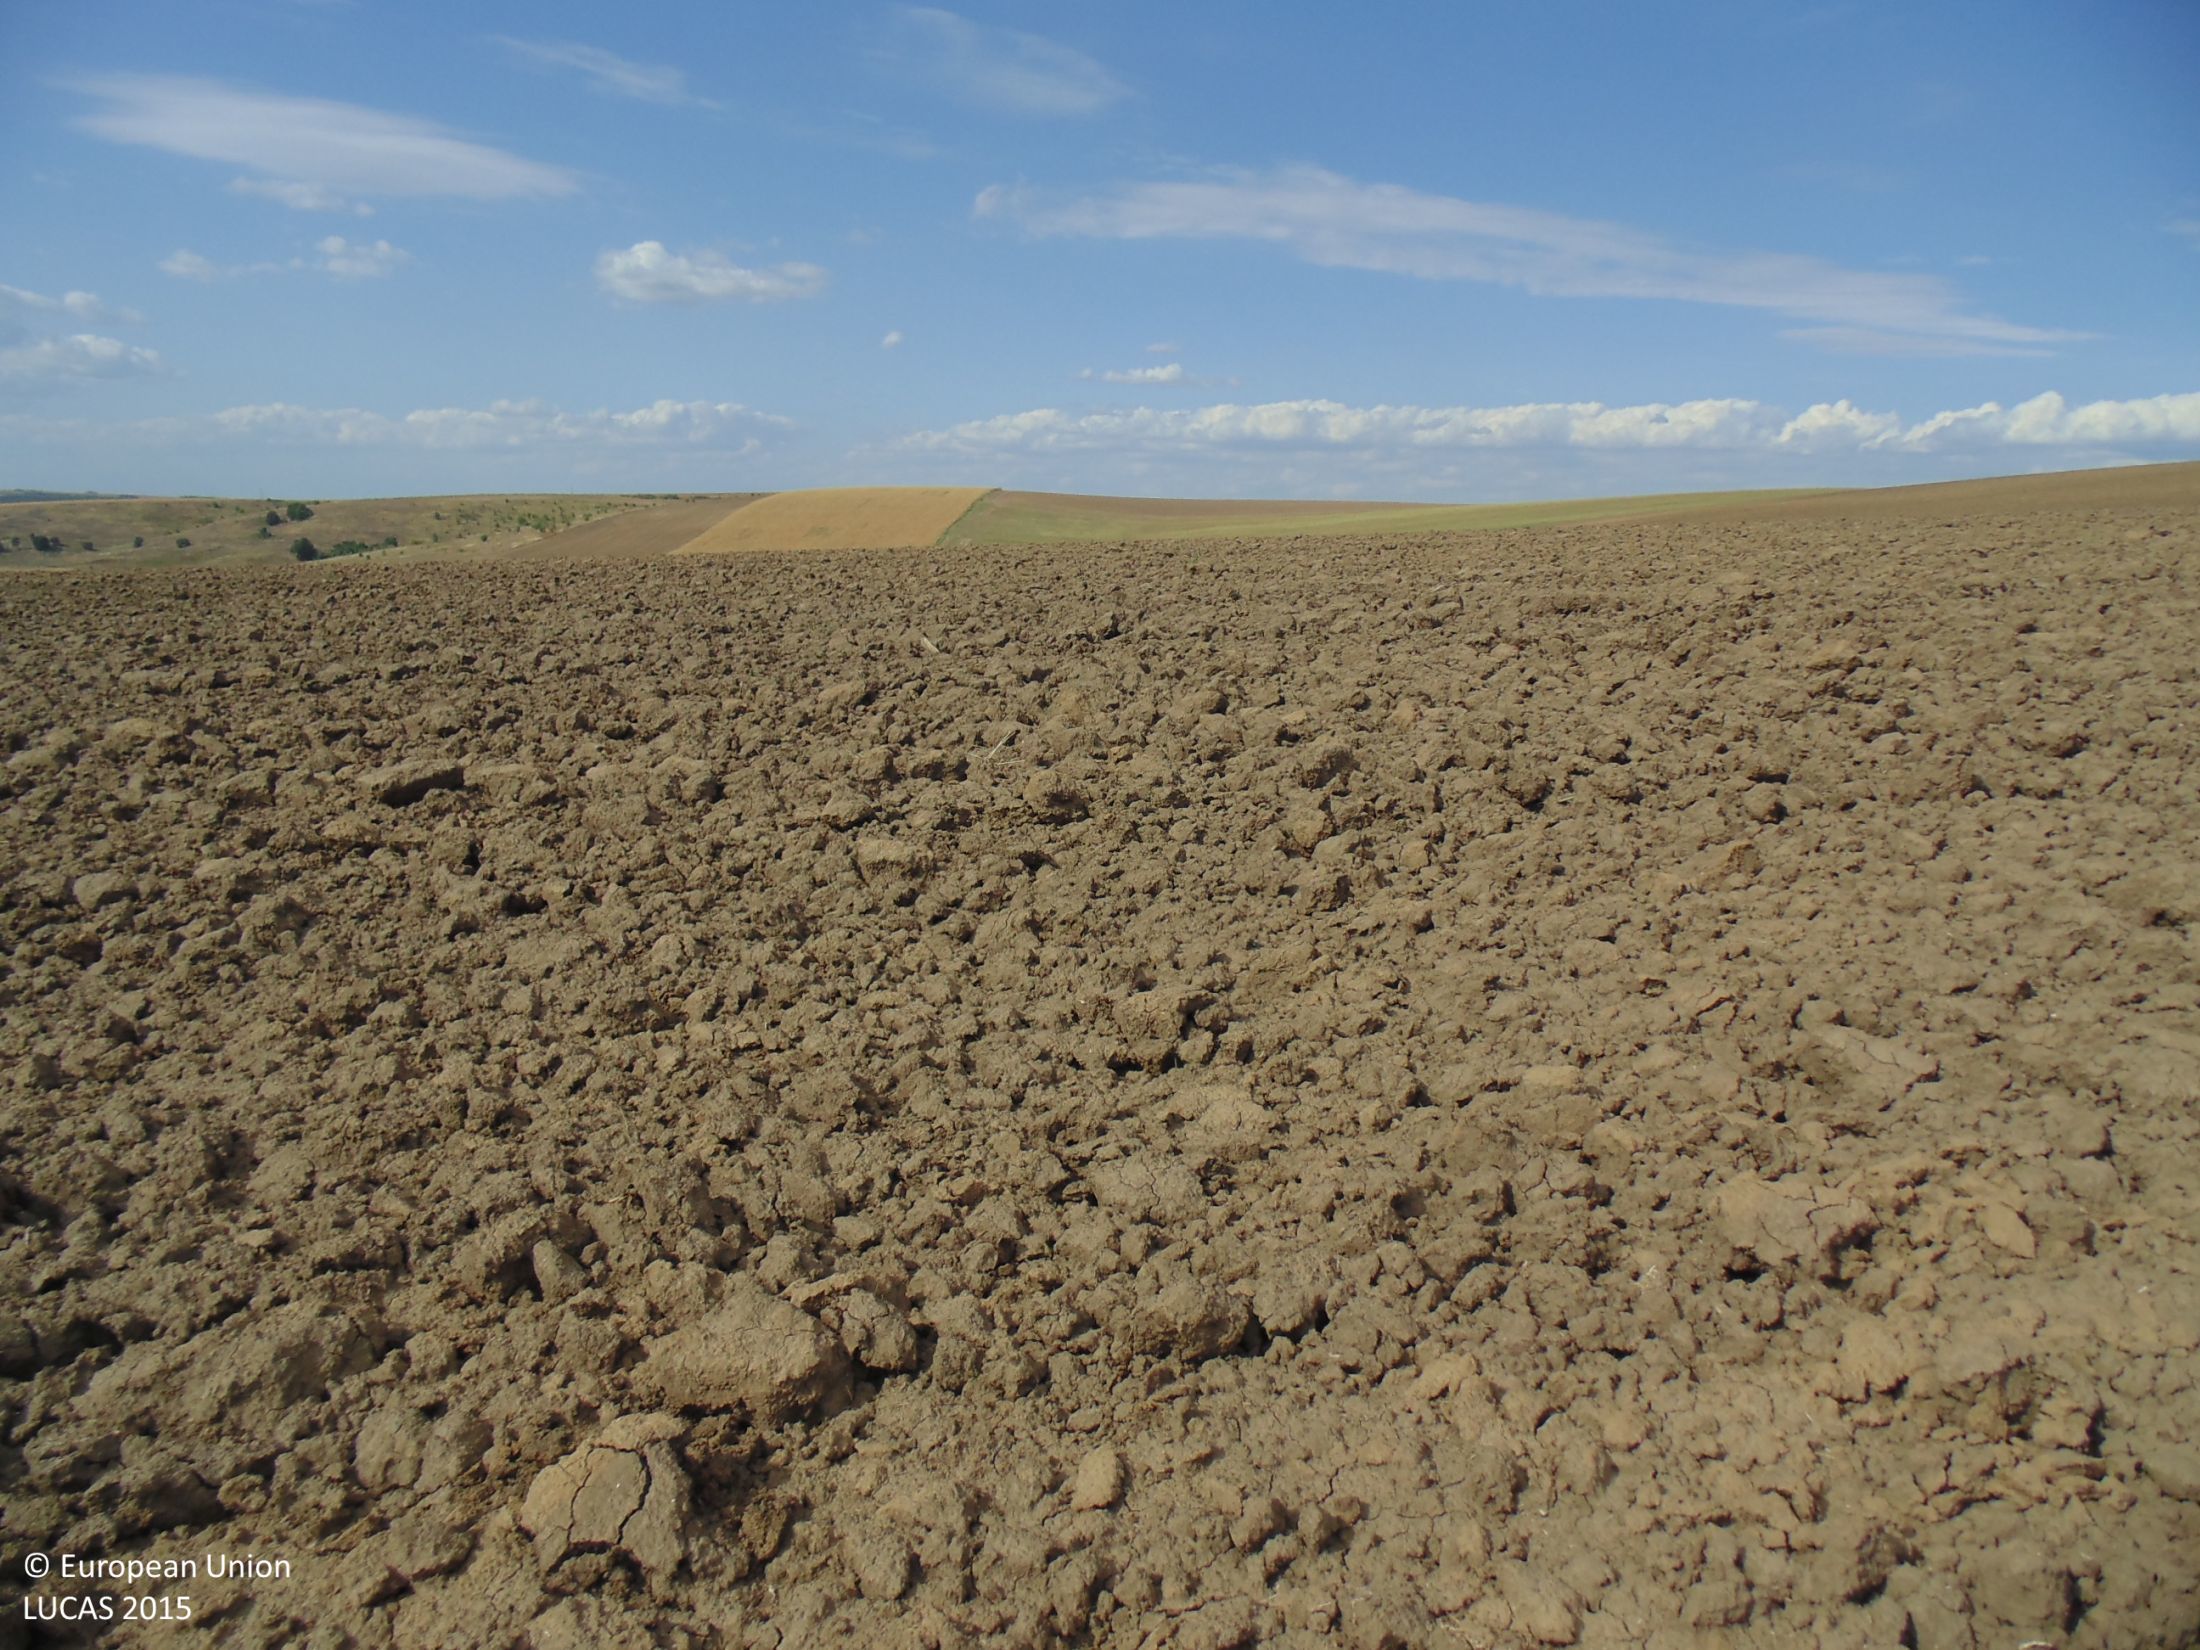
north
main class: Cropland
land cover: Common wheat
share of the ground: < 10 %
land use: Agriculture (excluding fallow land and kitchen gardens)
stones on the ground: < 10 %
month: September
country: BG
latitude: 44.0783
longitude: 27.0970
